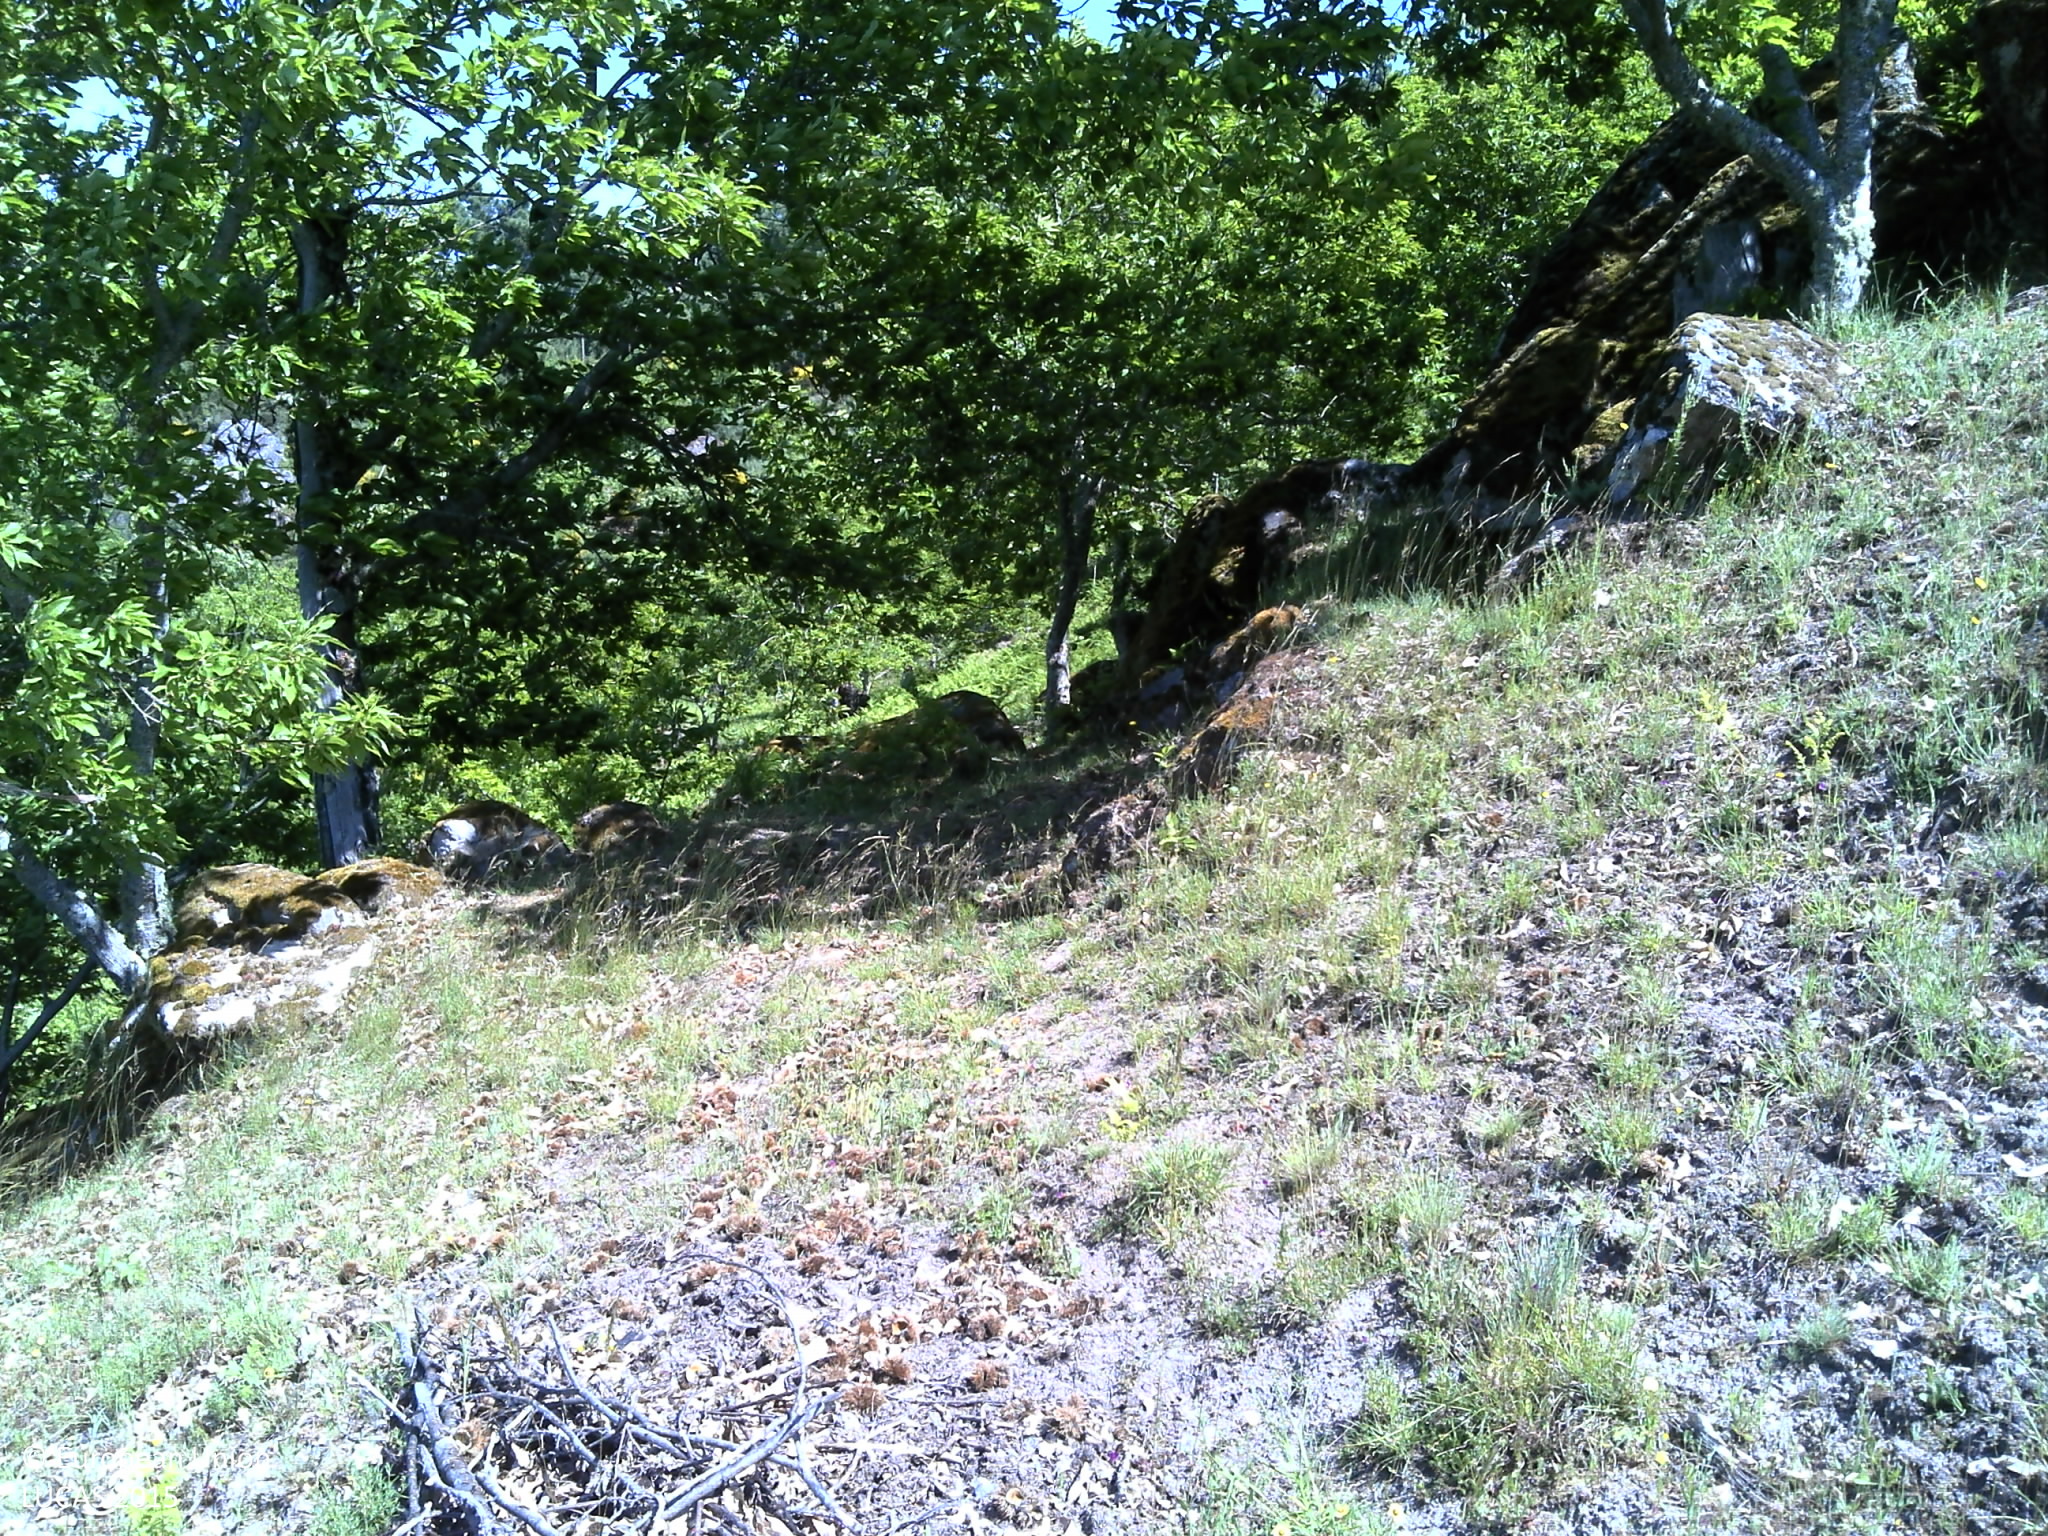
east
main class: Cropland
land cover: Nuts trees
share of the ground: 25 - 50 %
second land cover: Grassland without tree/shrub cover
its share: 50 - 75 %
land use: Agriculture (excluding fallow land and kitchen gardens)
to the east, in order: Nuts trees; Grassland without tree/shrub cover; Nuts trees; Shrubland with sparse tree cover; Pine dominated coniferous woodland
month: May
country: PT
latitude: 41.5853
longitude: -7.5592
